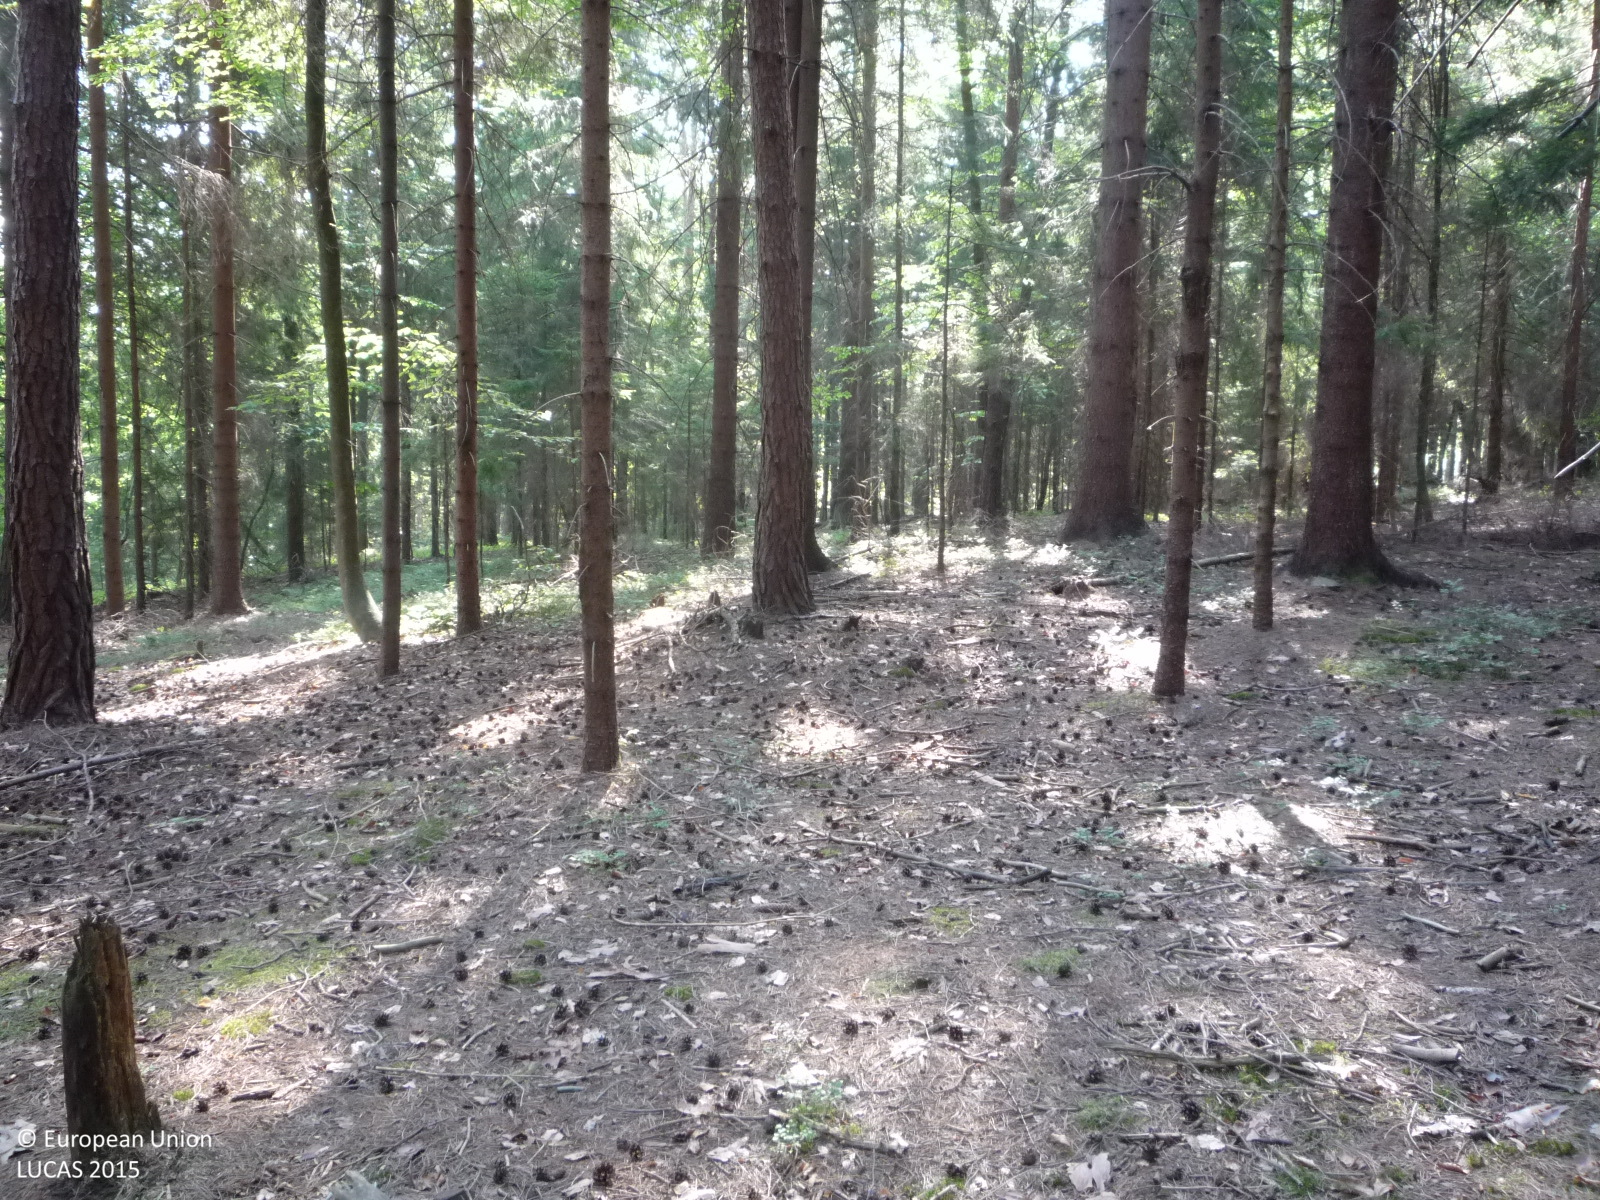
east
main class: Woodland
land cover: Spruce dominated coniferous woodland
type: hemiboreal forest and nemoral coniferous forest and mixed broadleaved-coniferous forest
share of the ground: > 75 %
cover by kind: coniferous forest trees 90 %, shrubs 5 %, unconsolidated bare surface 5 %
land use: Forestry
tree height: > 5 m
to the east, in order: Spruce dominated coniferous woodland; Tracks; Spruce dominated coniferous woodland
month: August
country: CZ
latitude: 50.6938
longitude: 15.2556
